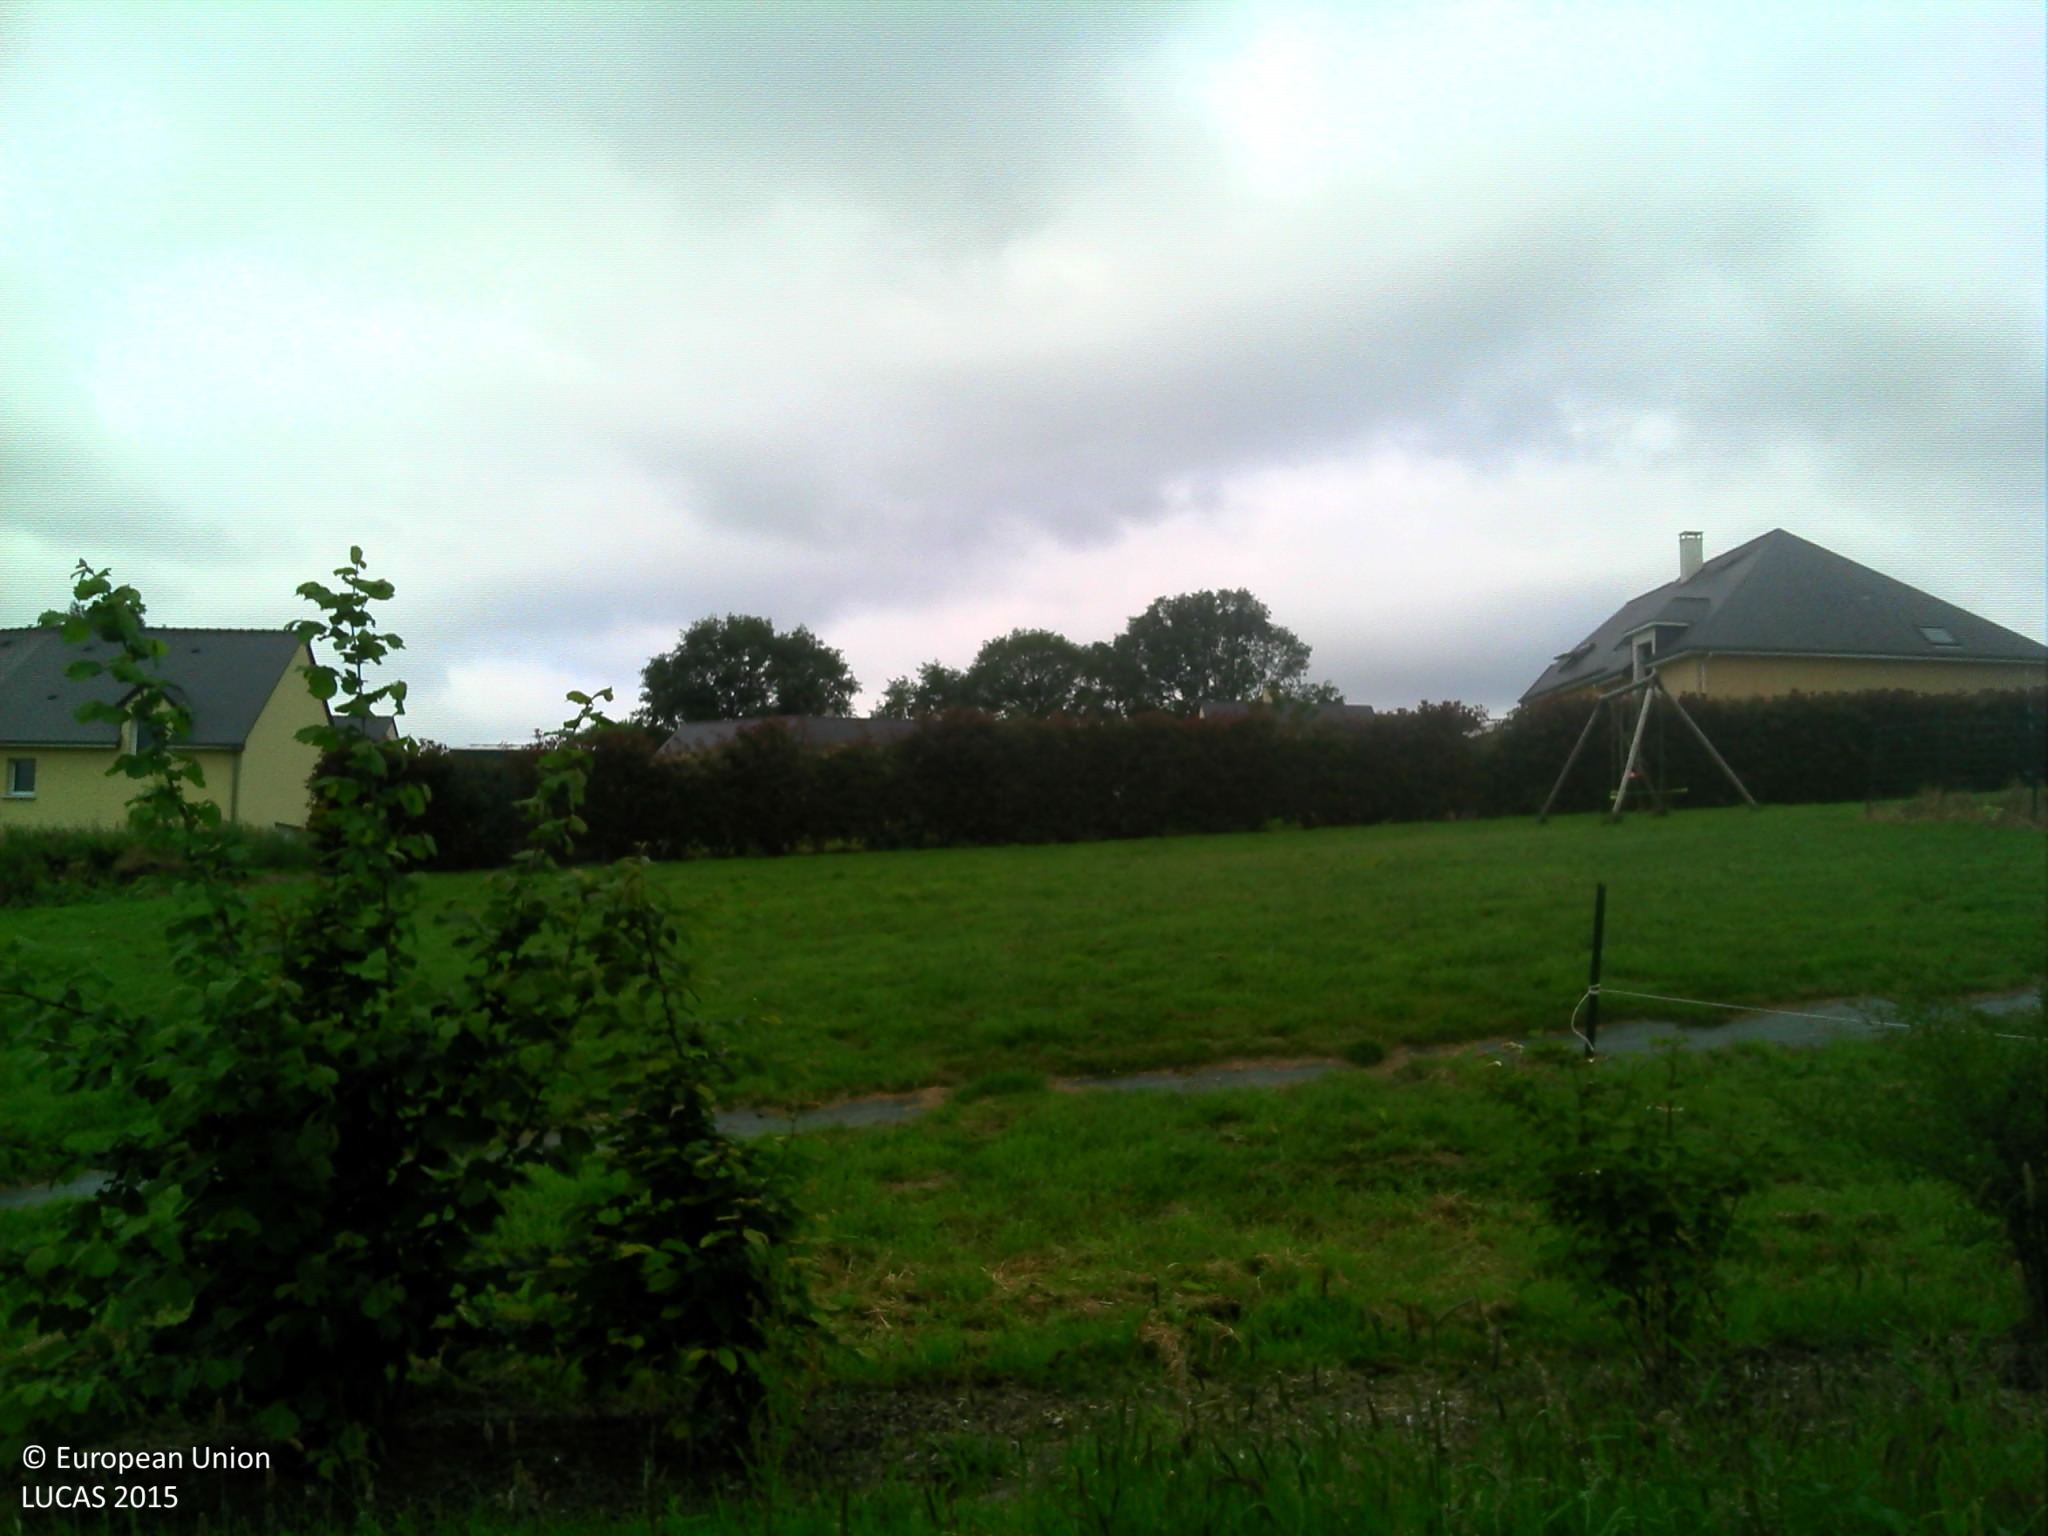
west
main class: Grassland
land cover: Grassland without tree/shrub cover
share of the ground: > 75 %
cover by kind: herbaceous plants 100 %
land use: Residential
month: May
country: FR
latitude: 48.1907
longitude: -0.1325
